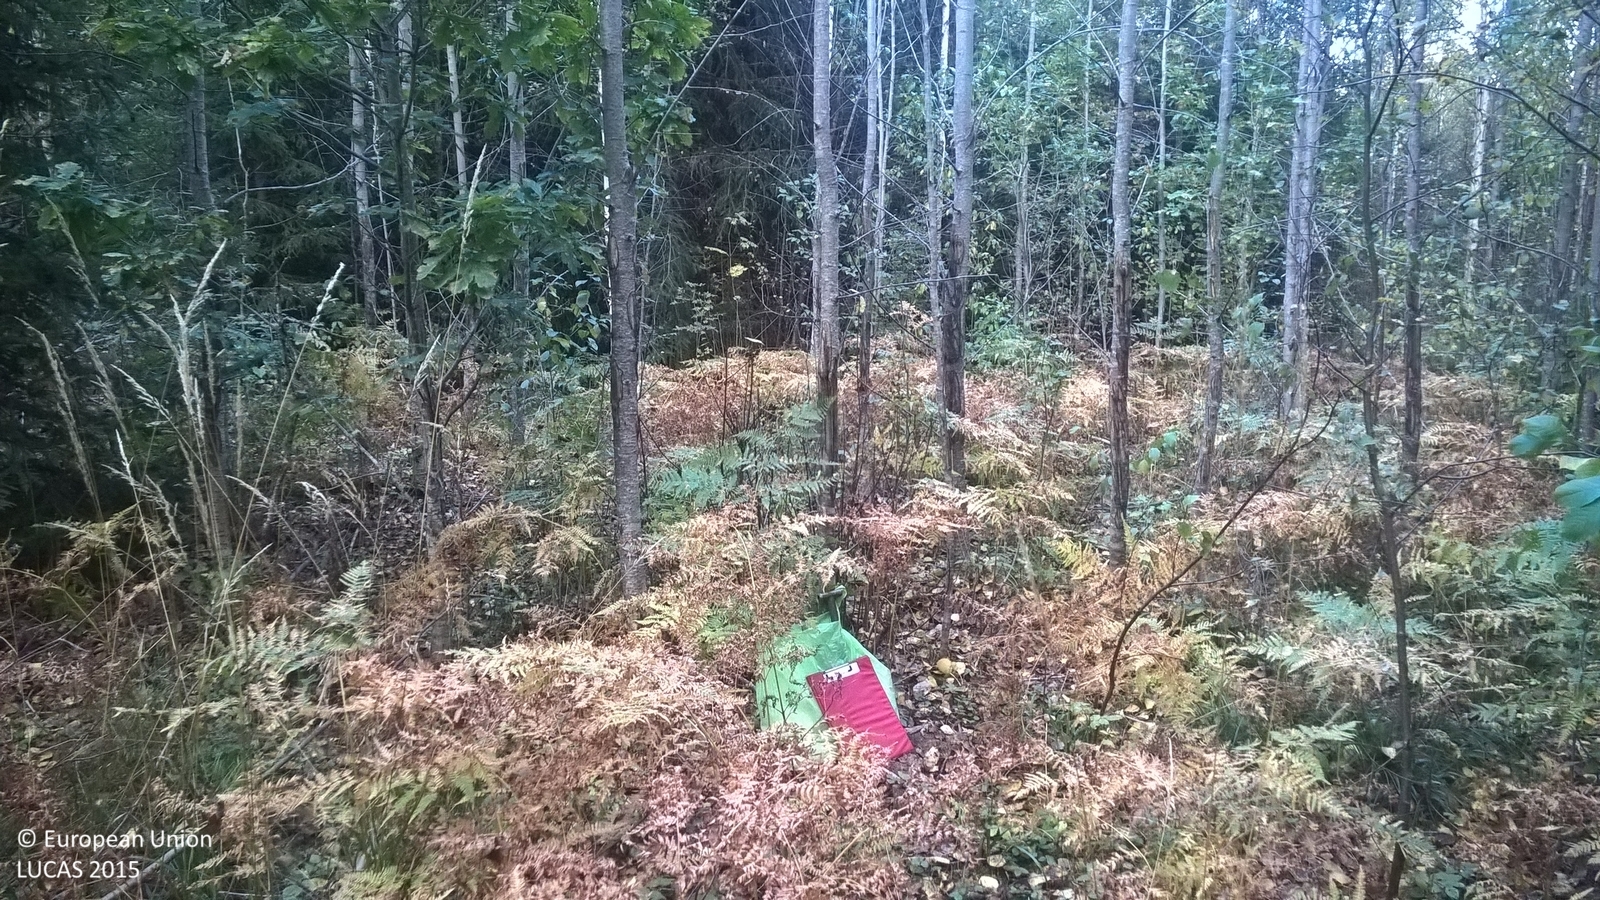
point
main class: Woodland
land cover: Spruce dominated mixed woodland
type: hemiboreal forest and nemoral coniferous forest and mixed broadleaved-coniferous forest
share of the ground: > 75 %
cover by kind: broadleaved forest trees 45 %, coniferous forest trees 30 %, lichens and mosses 25 %
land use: Forestry
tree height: > 5 m
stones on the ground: < 10 %
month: September
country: LV
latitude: 57.6473
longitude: 25.6154
